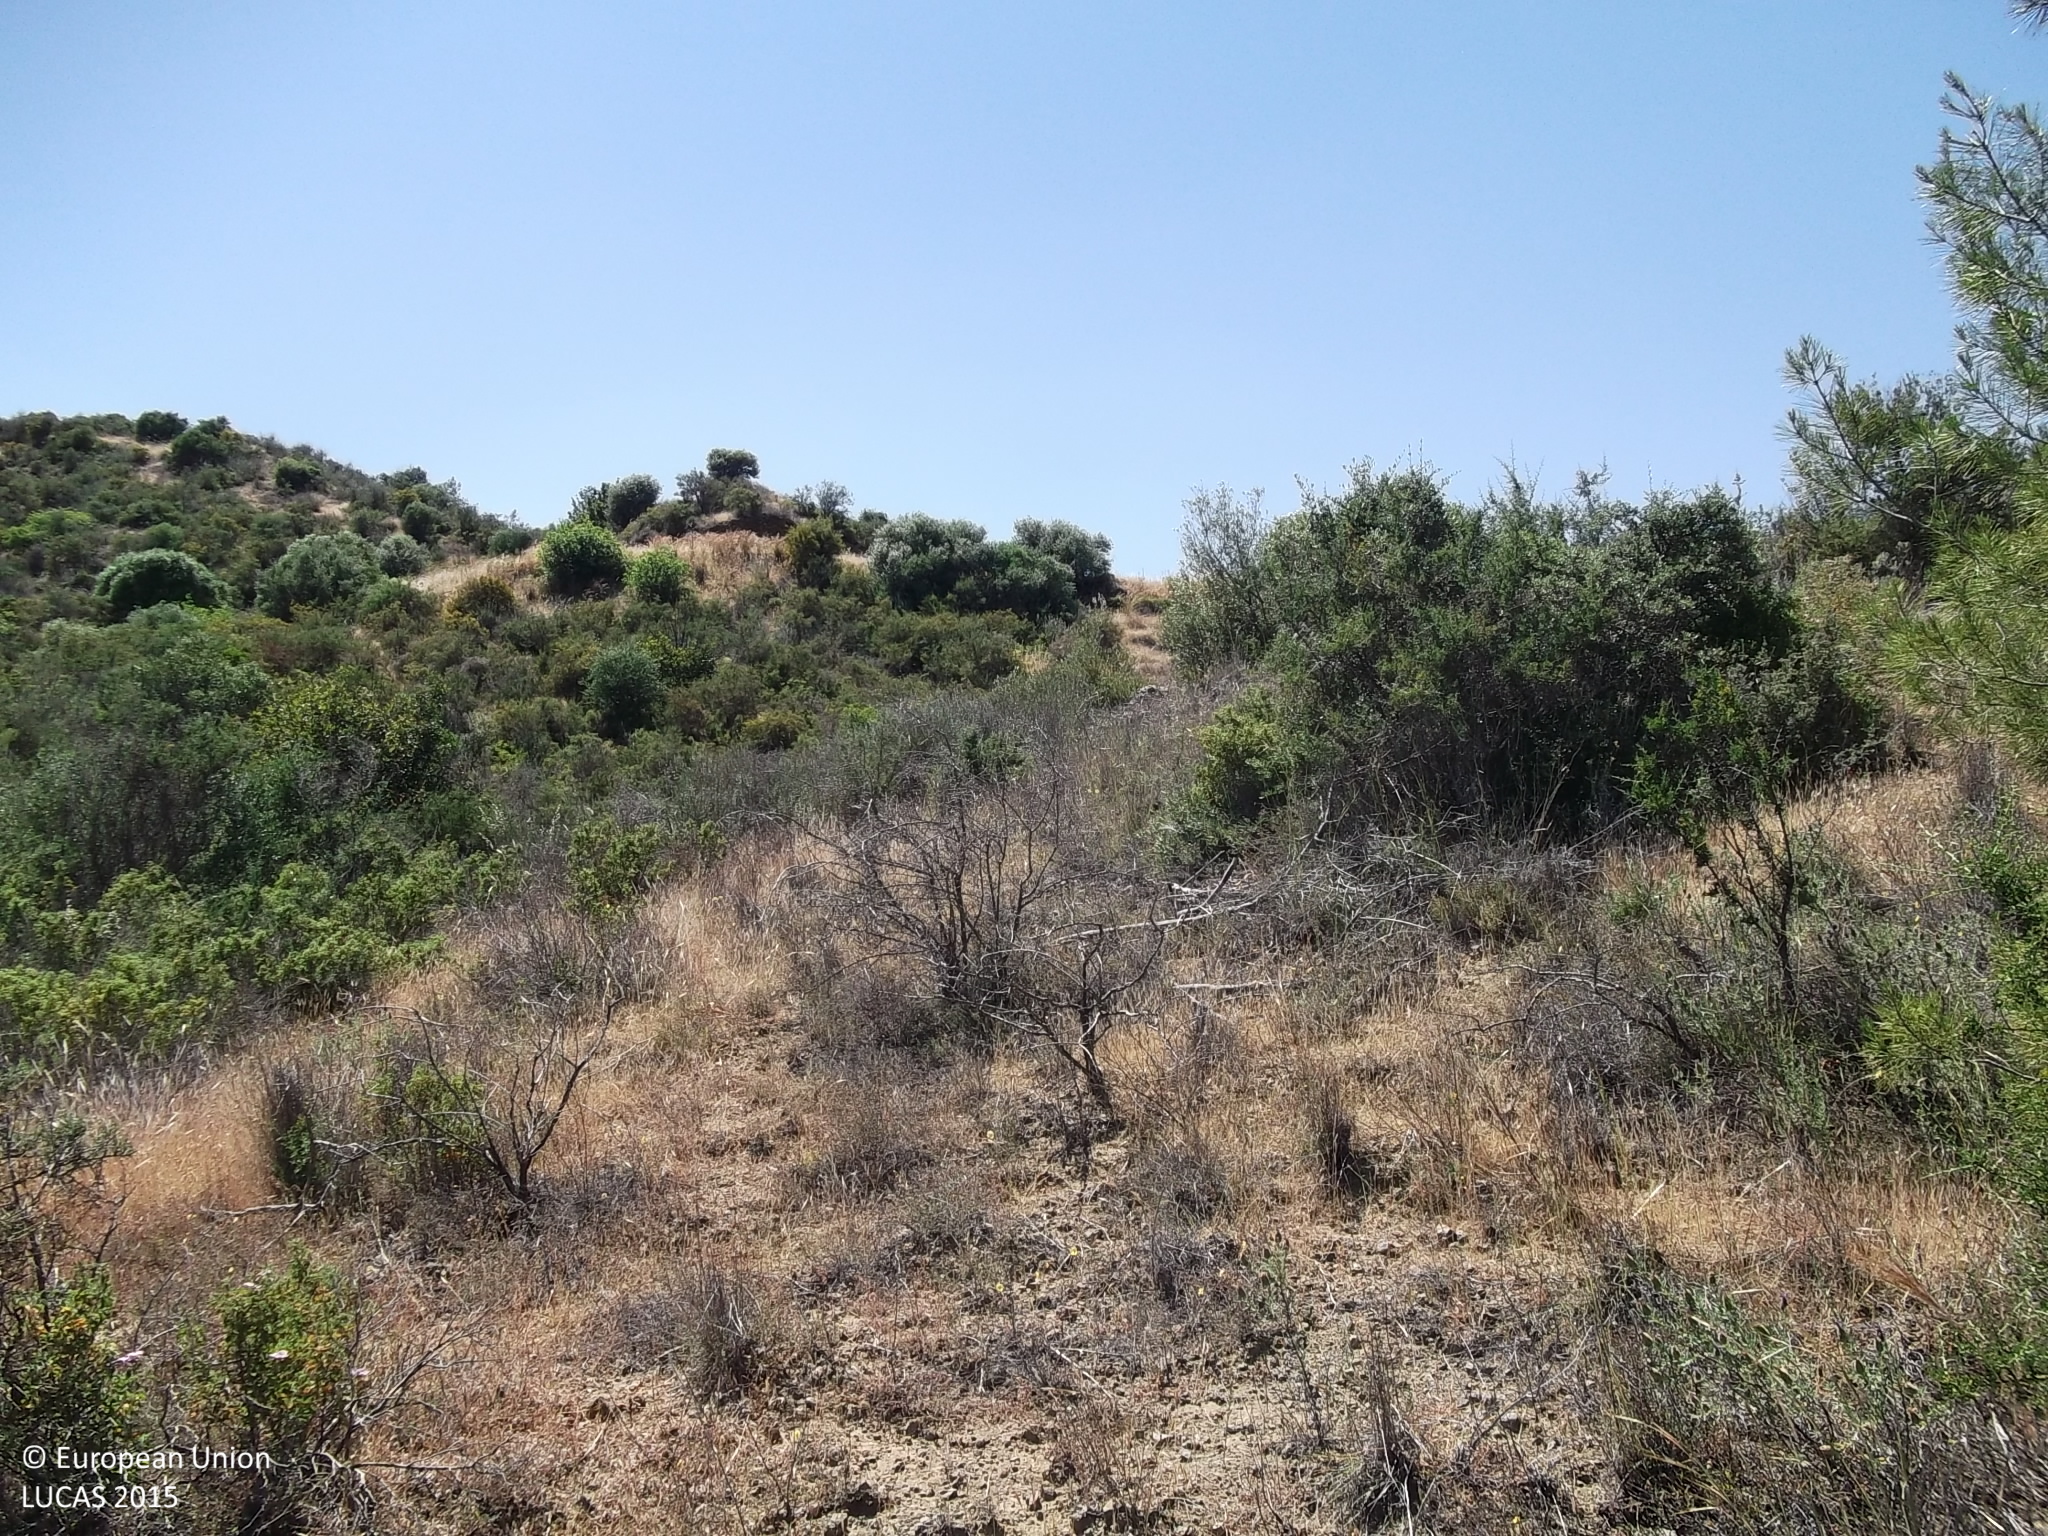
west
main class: Shrubland
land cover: Shrubland with sparse tree cover
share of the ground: 50 - 75 %
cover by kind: shrubs 65 %, herbaceous plants 15 %, unconsolidated bare surface 15 %, broadleaved forest trees 5 %
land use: Semi-natural and natural areas not in use
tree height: > 5 m
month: May
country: CY
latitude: 34.8798
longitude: 33.3223
